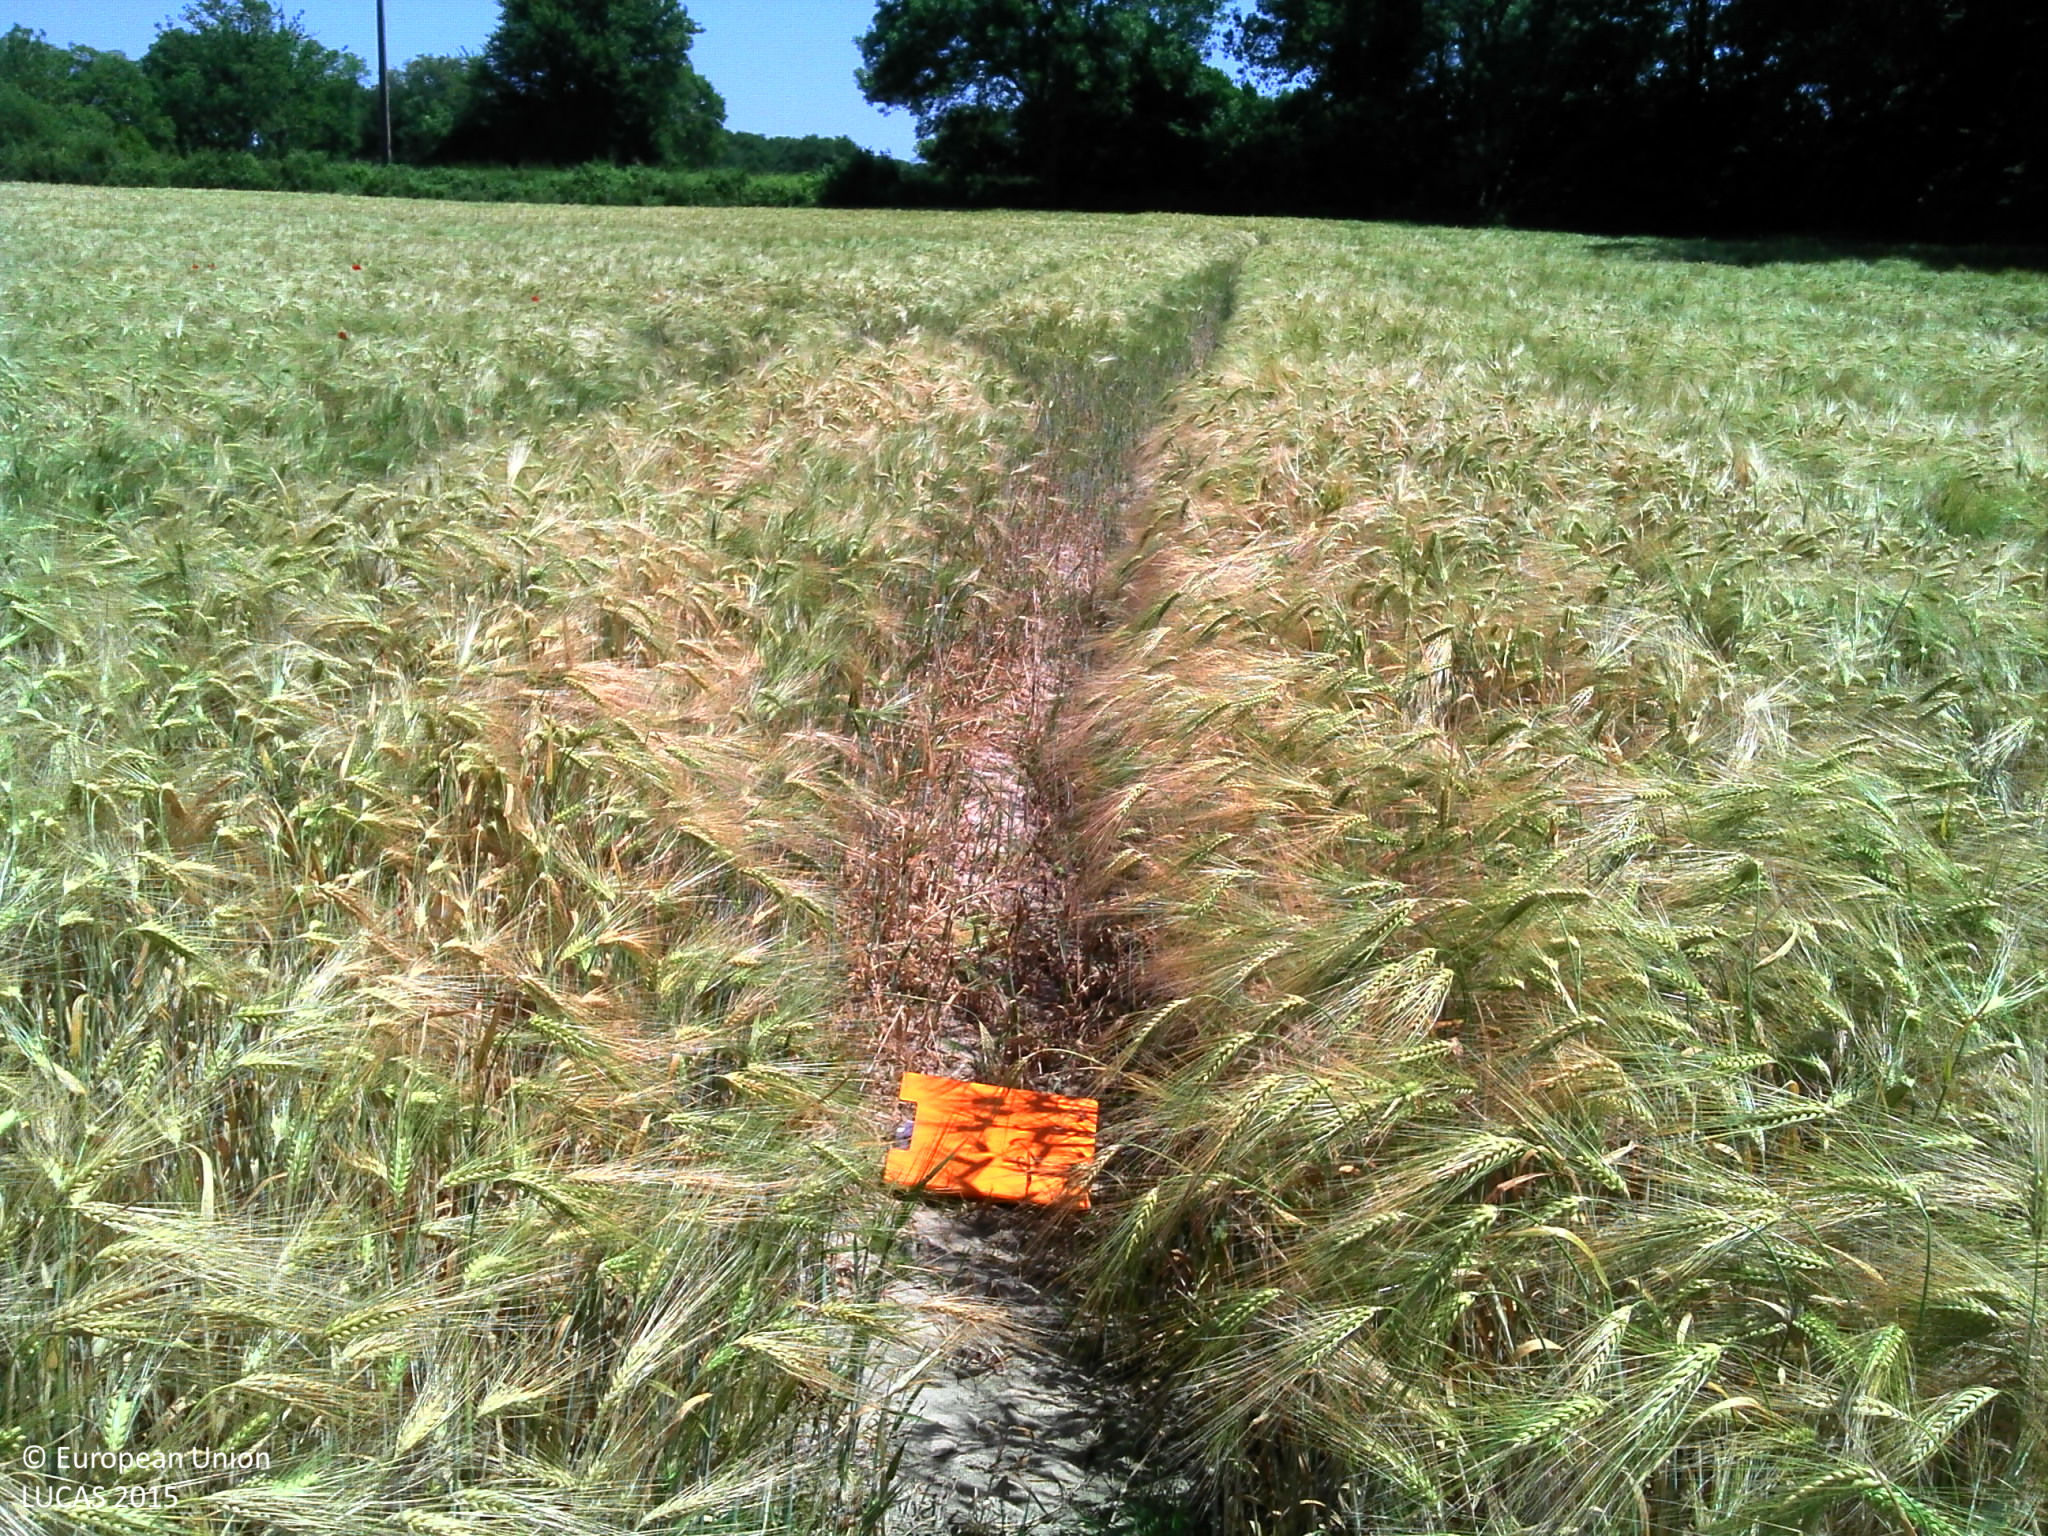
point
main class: Cropland
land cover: Barley
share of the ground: > 75 %
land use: Agriculture (excluding fallow land and kitchen gardens)
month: June
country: FR
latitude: 46.8955
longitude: 2.9473
